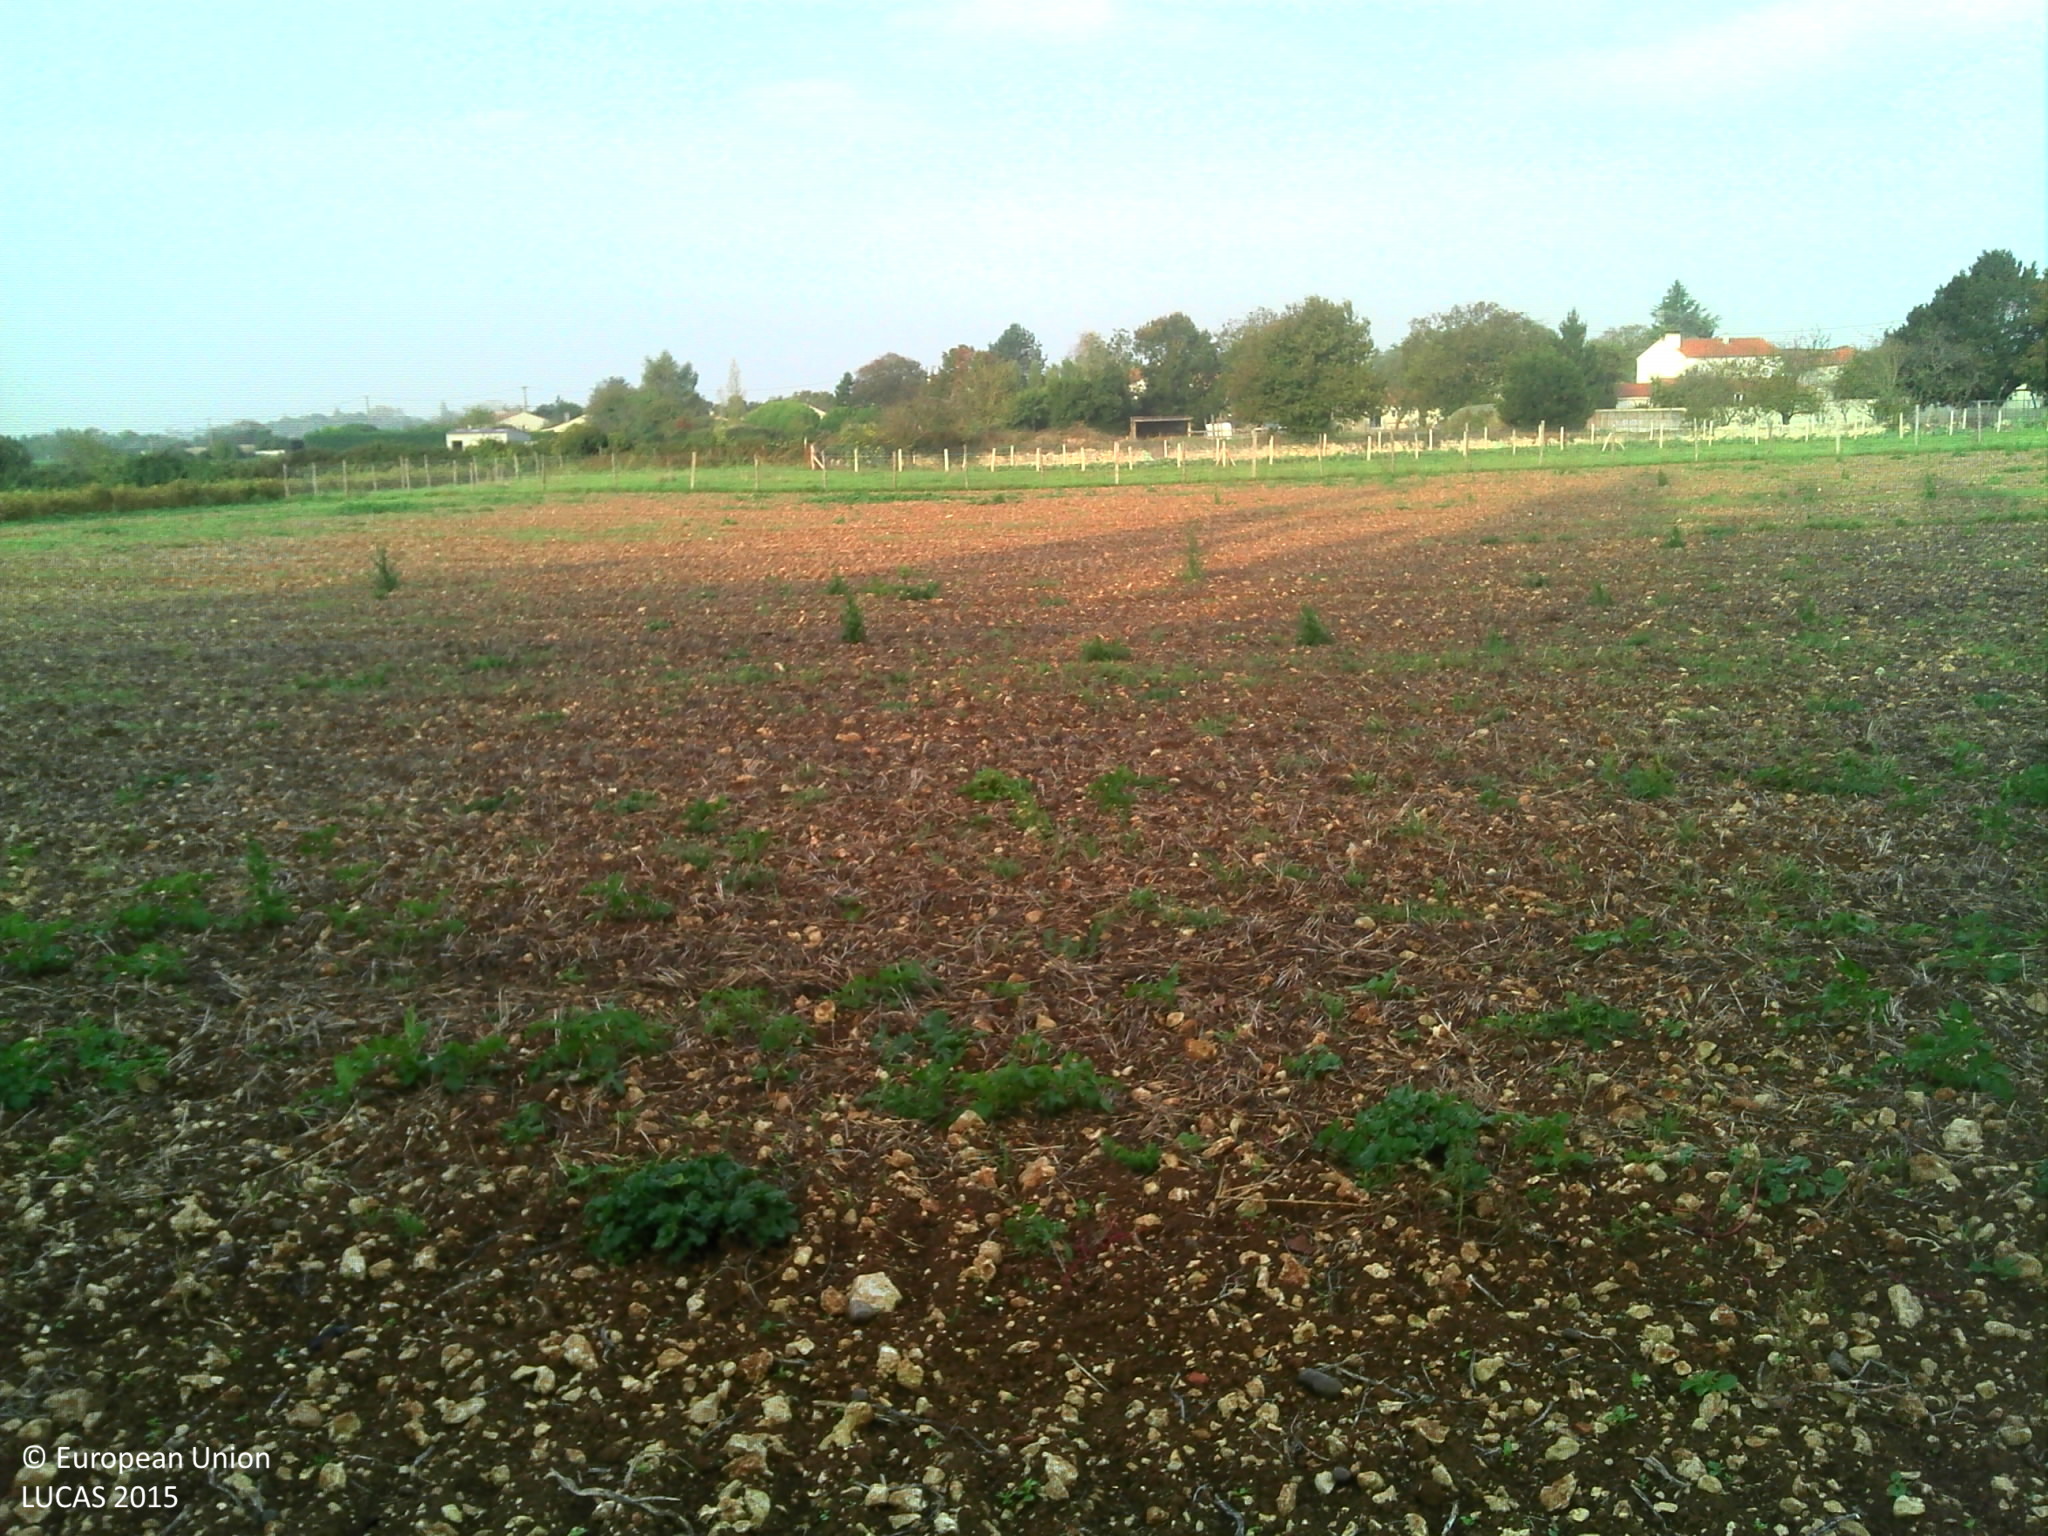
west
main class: Grassland
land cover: Spontaneously vegetated surfaces
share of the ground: 25 - 50 %
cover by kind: unconsolidated bare surface 85 %, herbaceous plants 15 %
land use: Fallow land
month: October
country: FR
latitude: 46.4688
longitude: -1.0364
